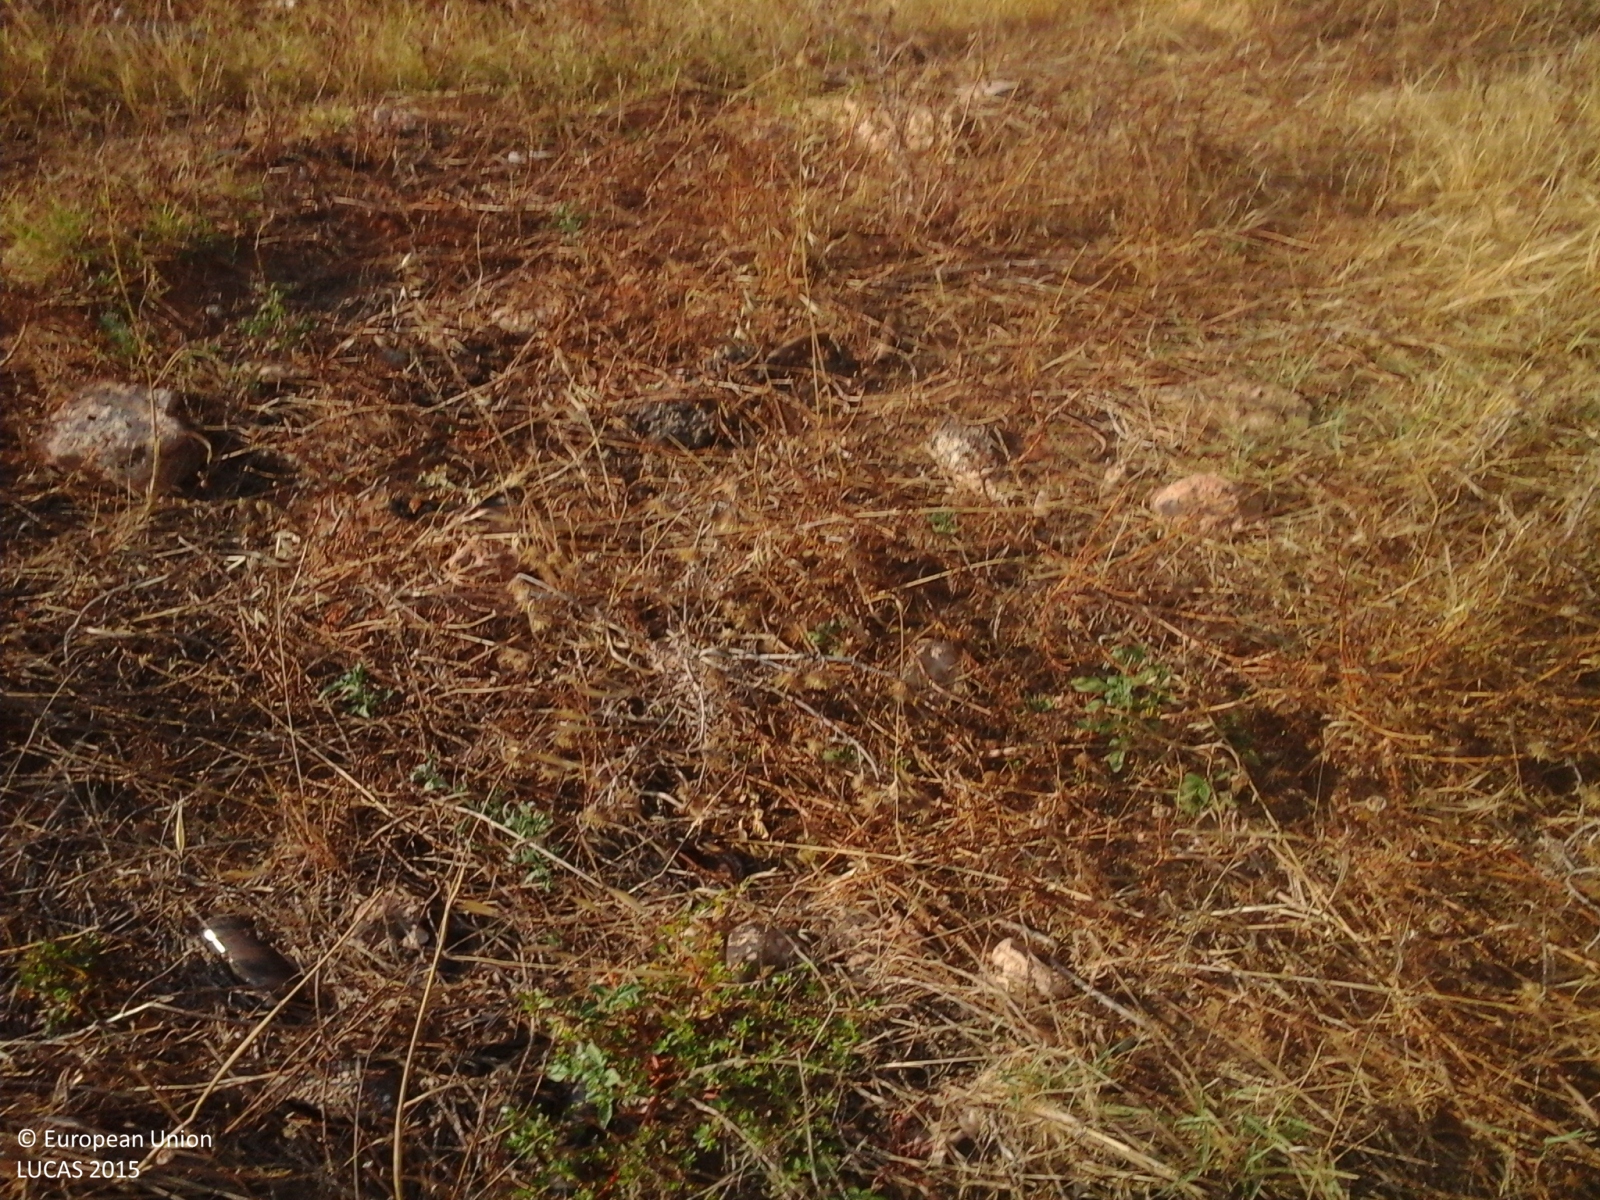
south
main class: Grassland
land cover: Grassland without tree/shrub cover
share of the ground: > 75 %
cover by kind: herbaceous plants 100 %
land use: Abandoned areas
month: July
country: IT
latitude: 36.9909
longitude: 14.4031
